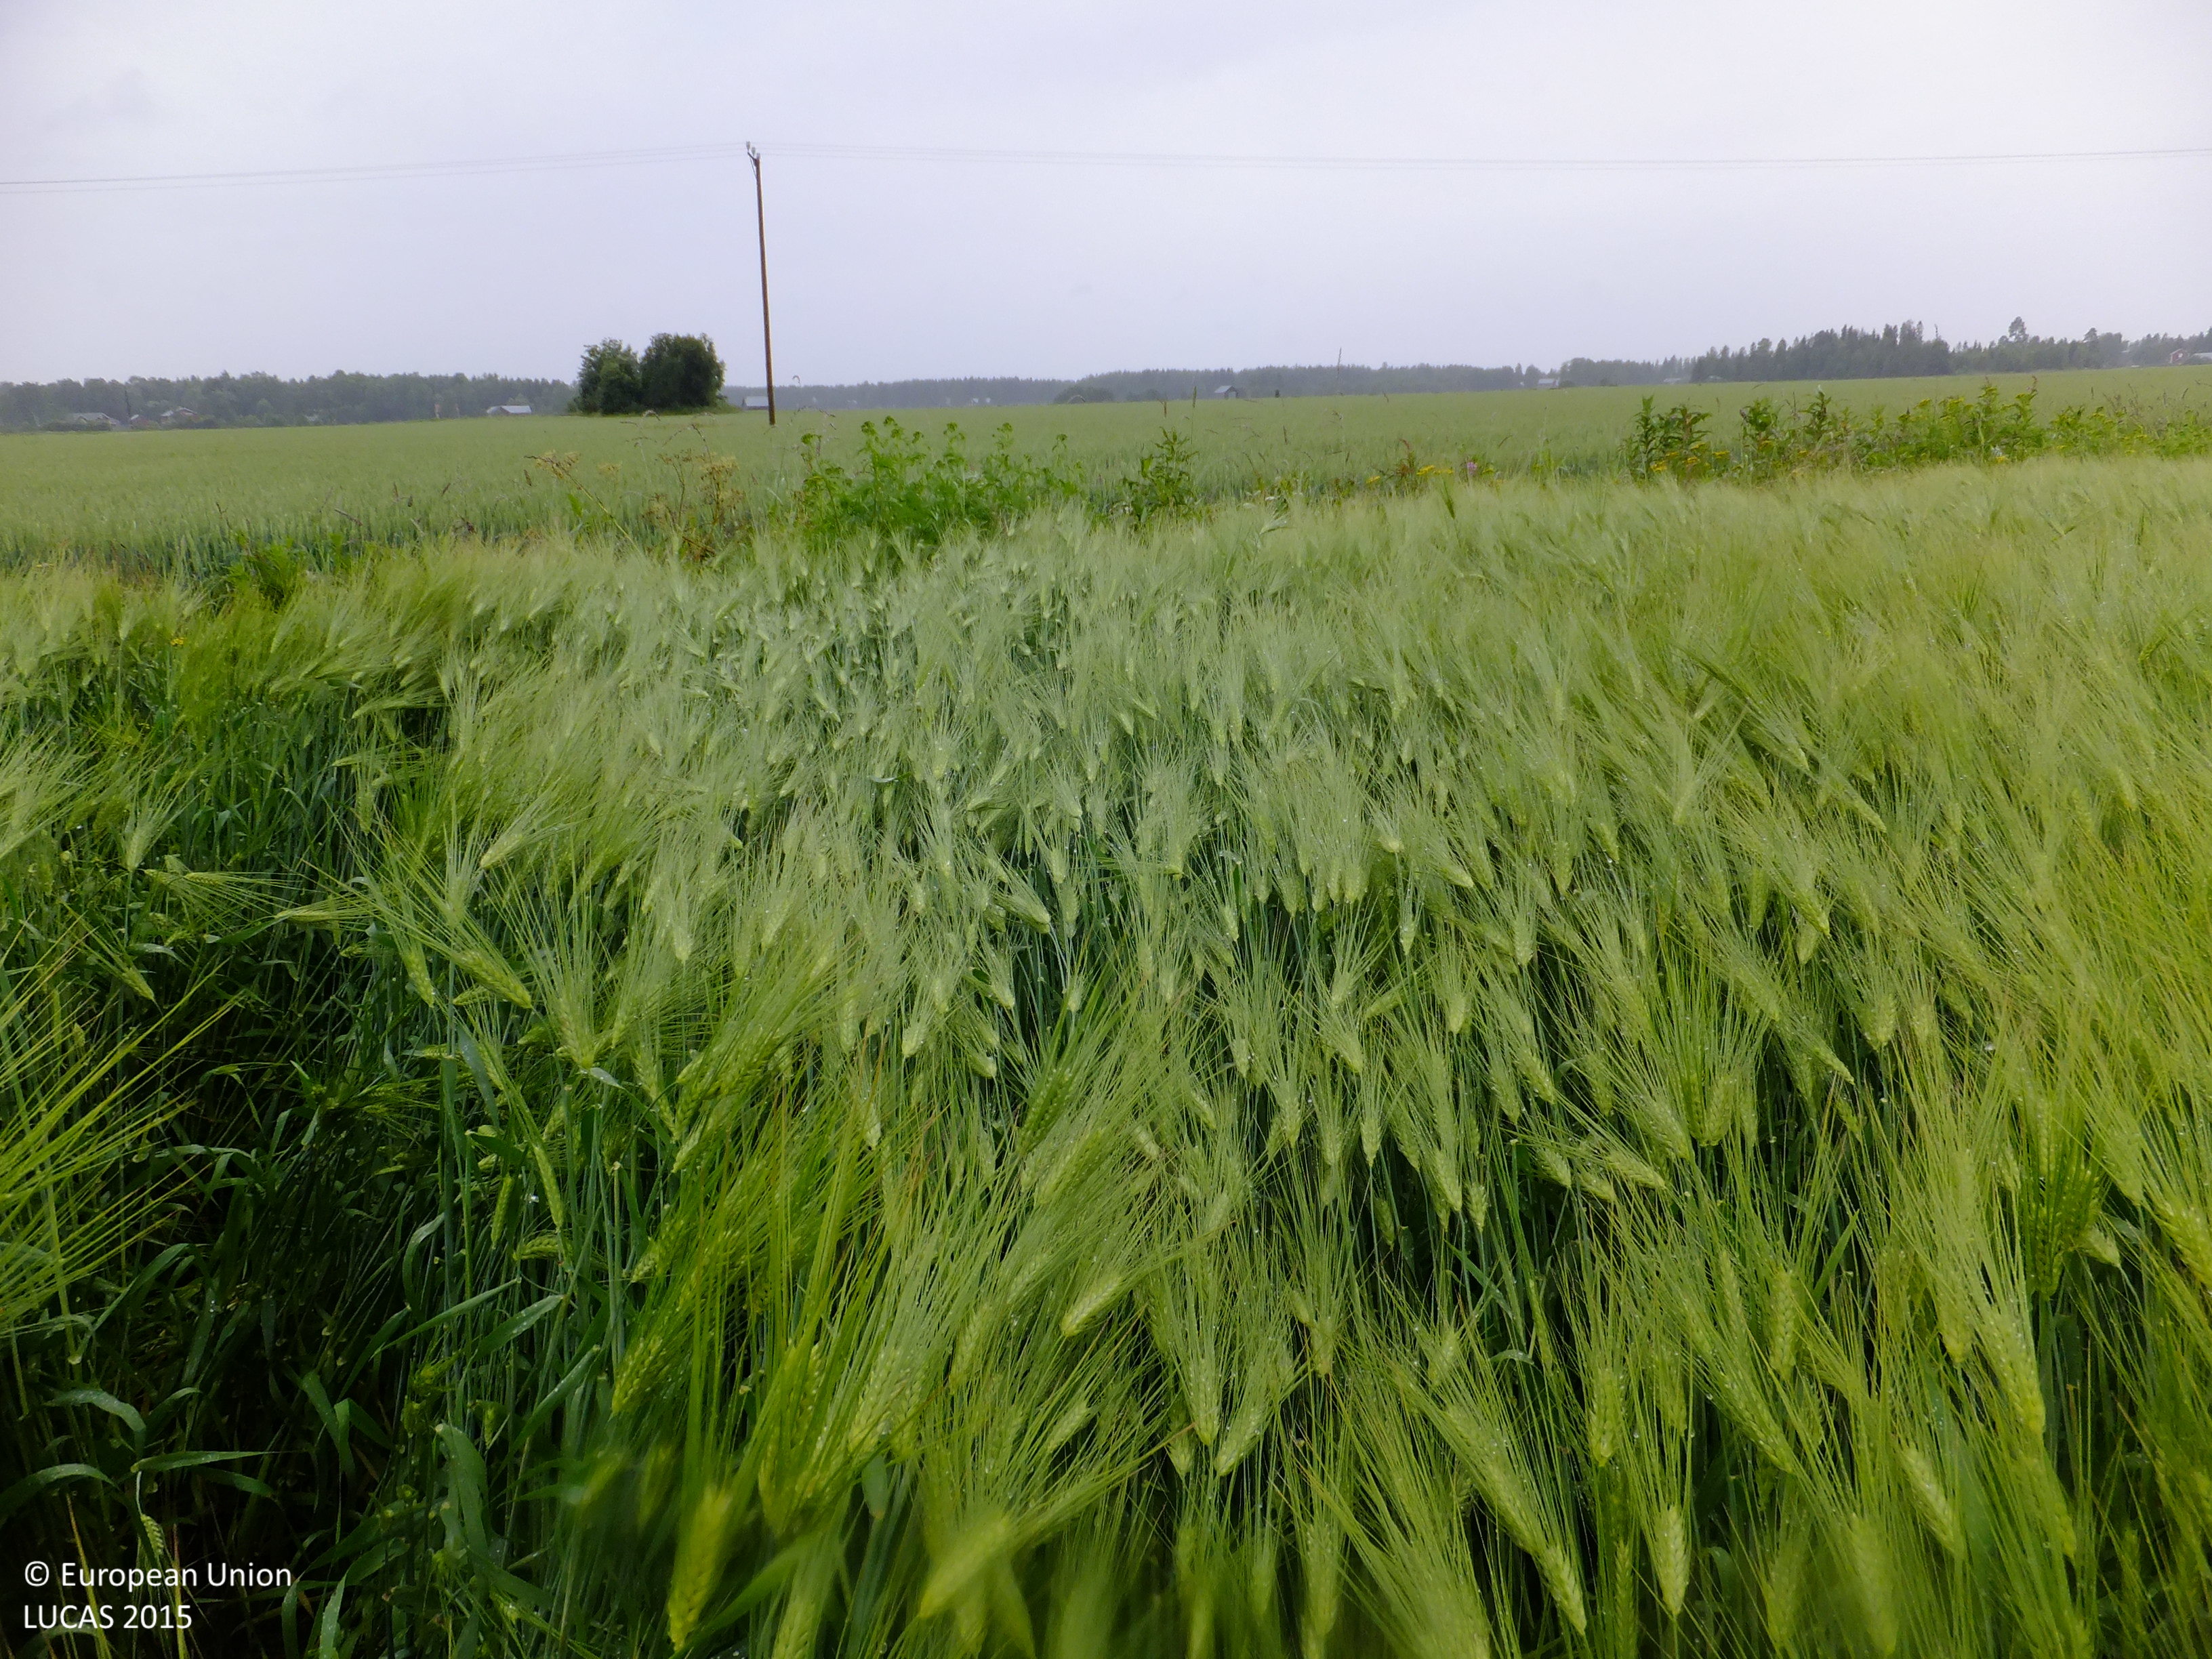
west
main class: Cropland
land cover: Barley
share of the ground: > 75 %
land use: Agriculture (excluding fallow land and kitchen gardens)
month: July
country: FI
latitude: 63.1833
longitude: 21.8637
